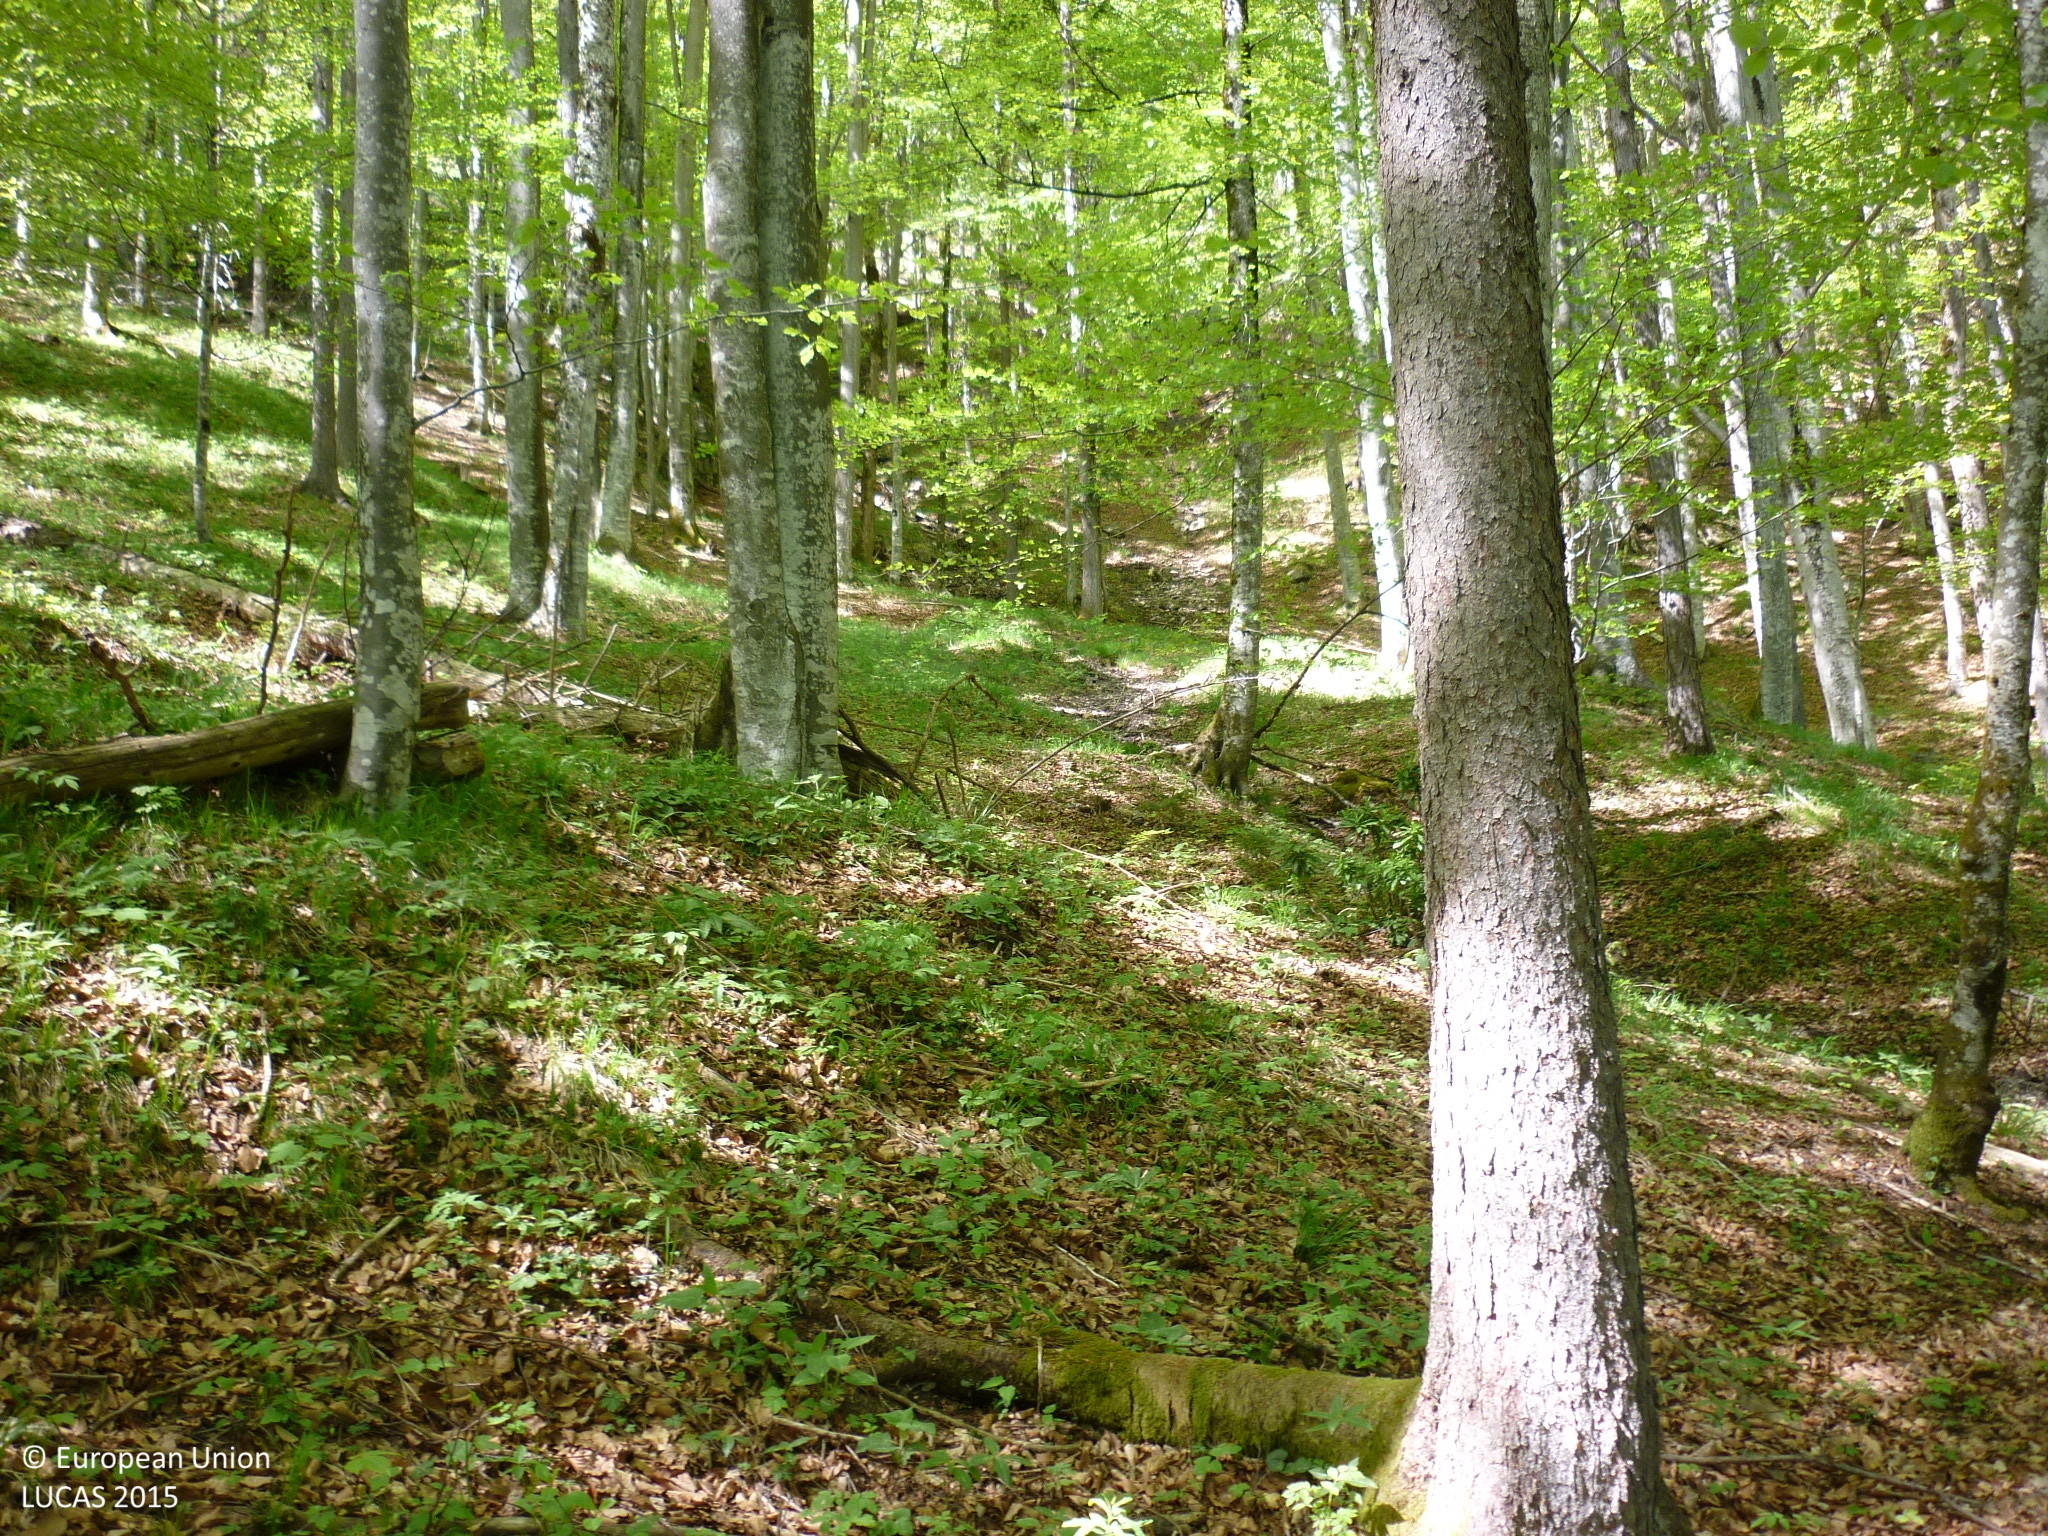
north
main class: Woodland
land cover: Broadleaved woodland
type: mountainous beech forest
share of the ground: > 75 %
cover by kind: broadleaved forest trees 95 %, herbaceous plants 5 %
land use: Forestry
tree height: > 5 m
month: May
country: AT
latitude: 47.6558
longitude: 14.6731
